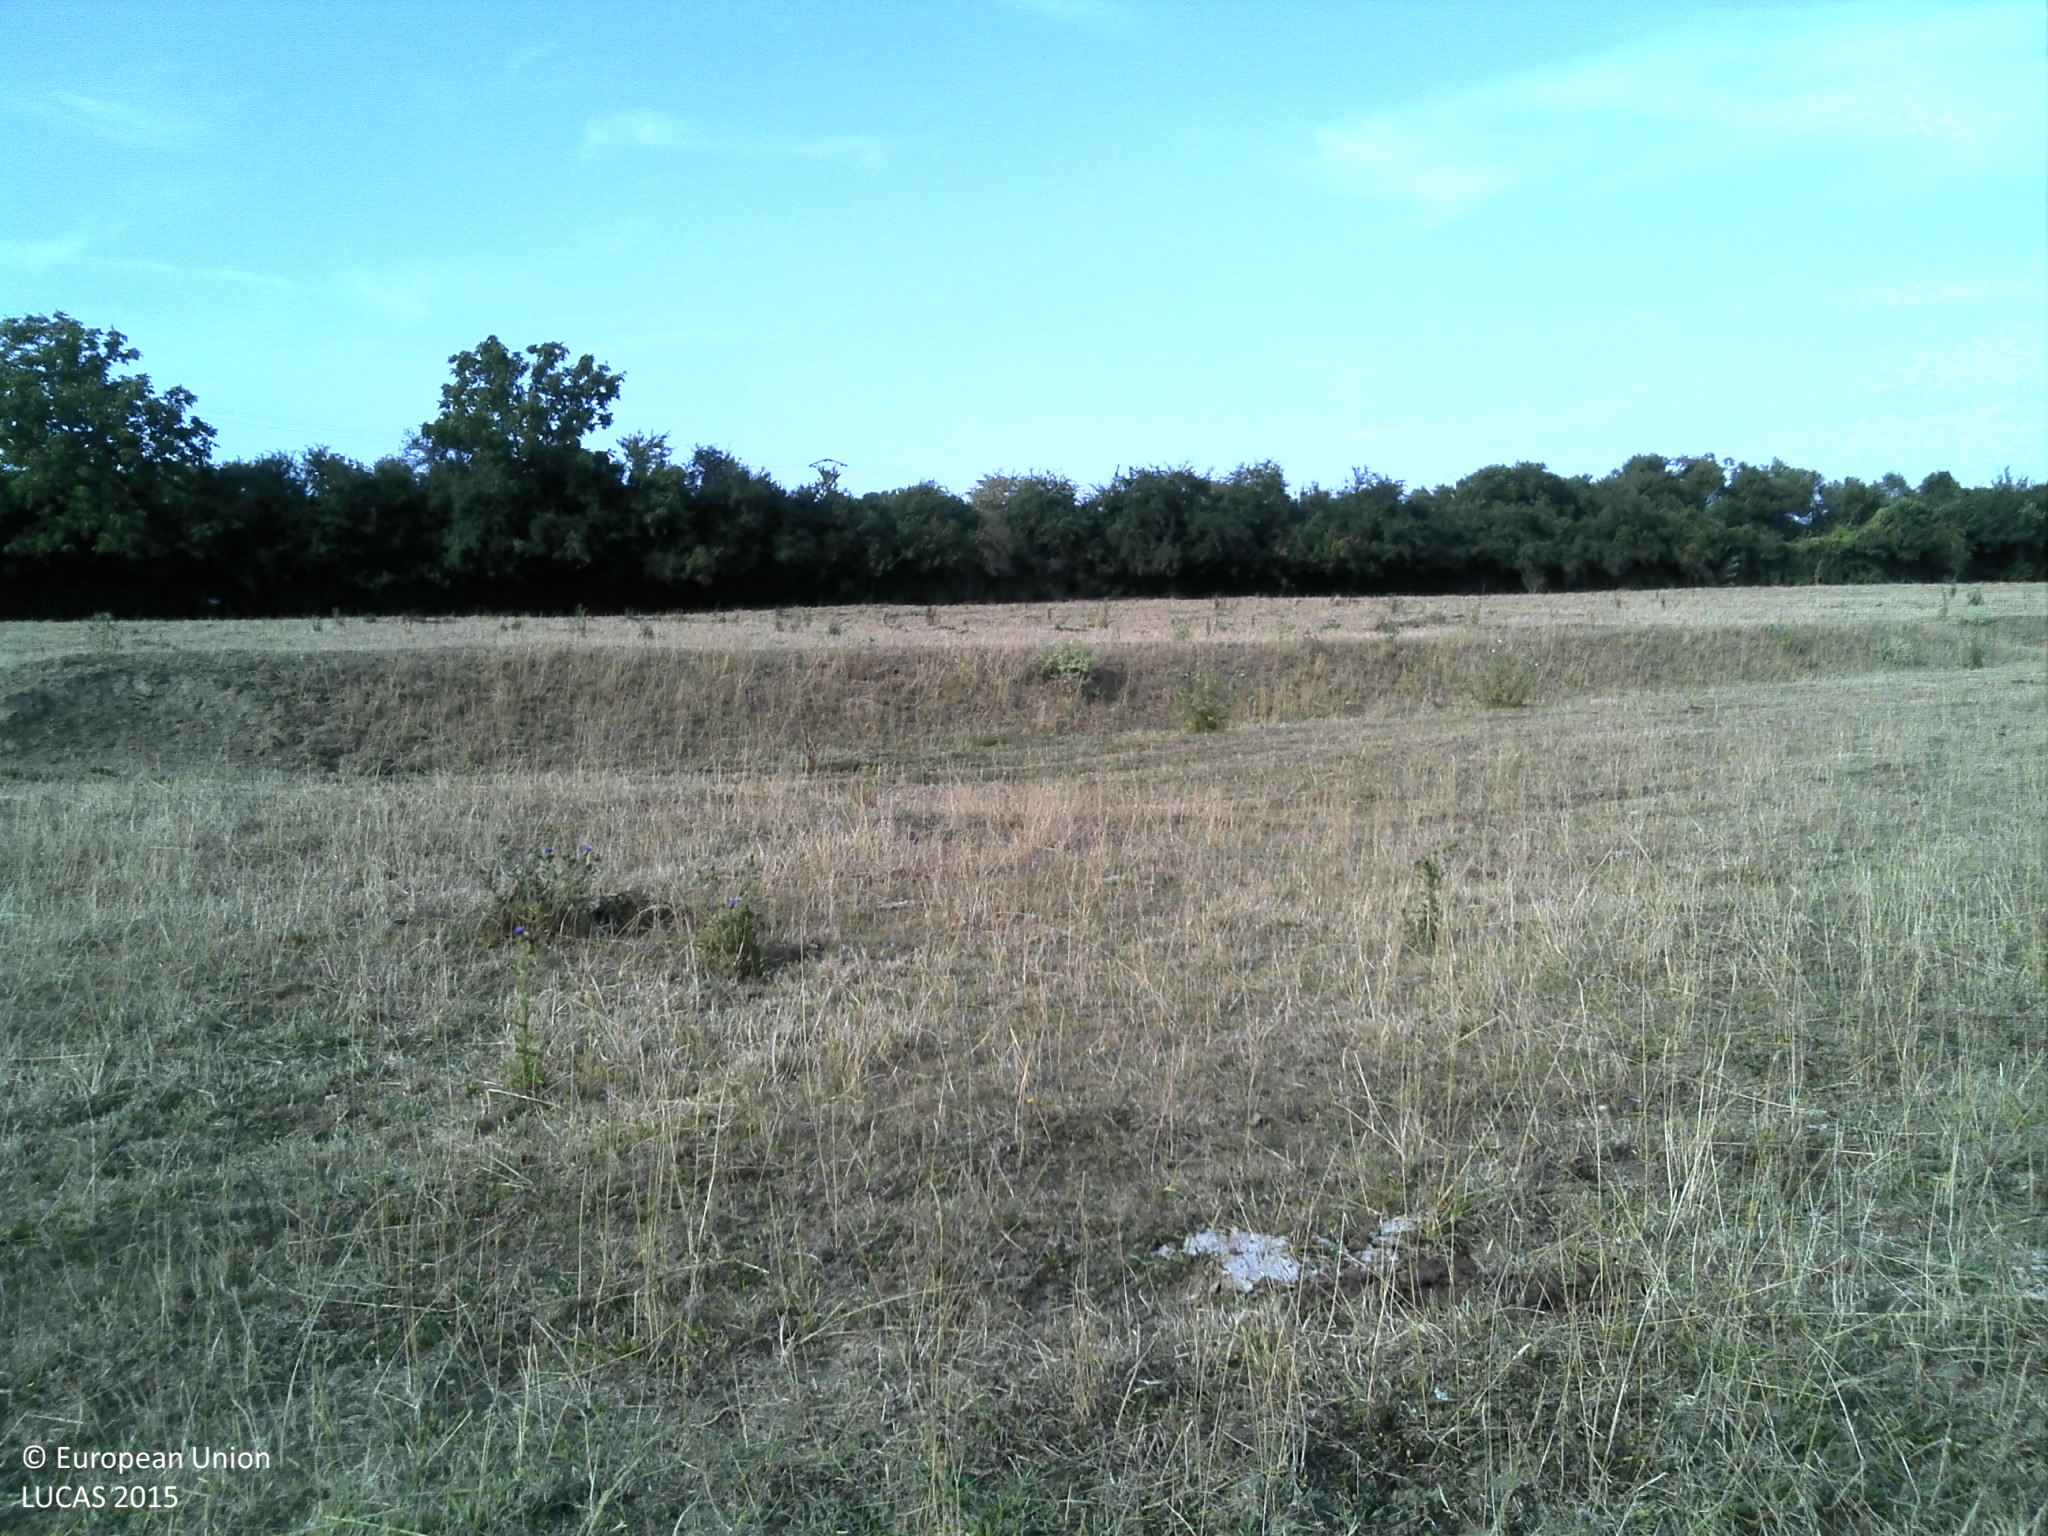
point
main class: Grassland
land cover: Grassland without tree/shrub cover
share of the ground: > 75 %
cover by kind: herbaceous plants 95 %, shrubs 5 %
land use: Agriculture (excluding fallow land and kitchen gardens)
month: August
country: FR
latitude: 49.0761
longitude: 4.8364
